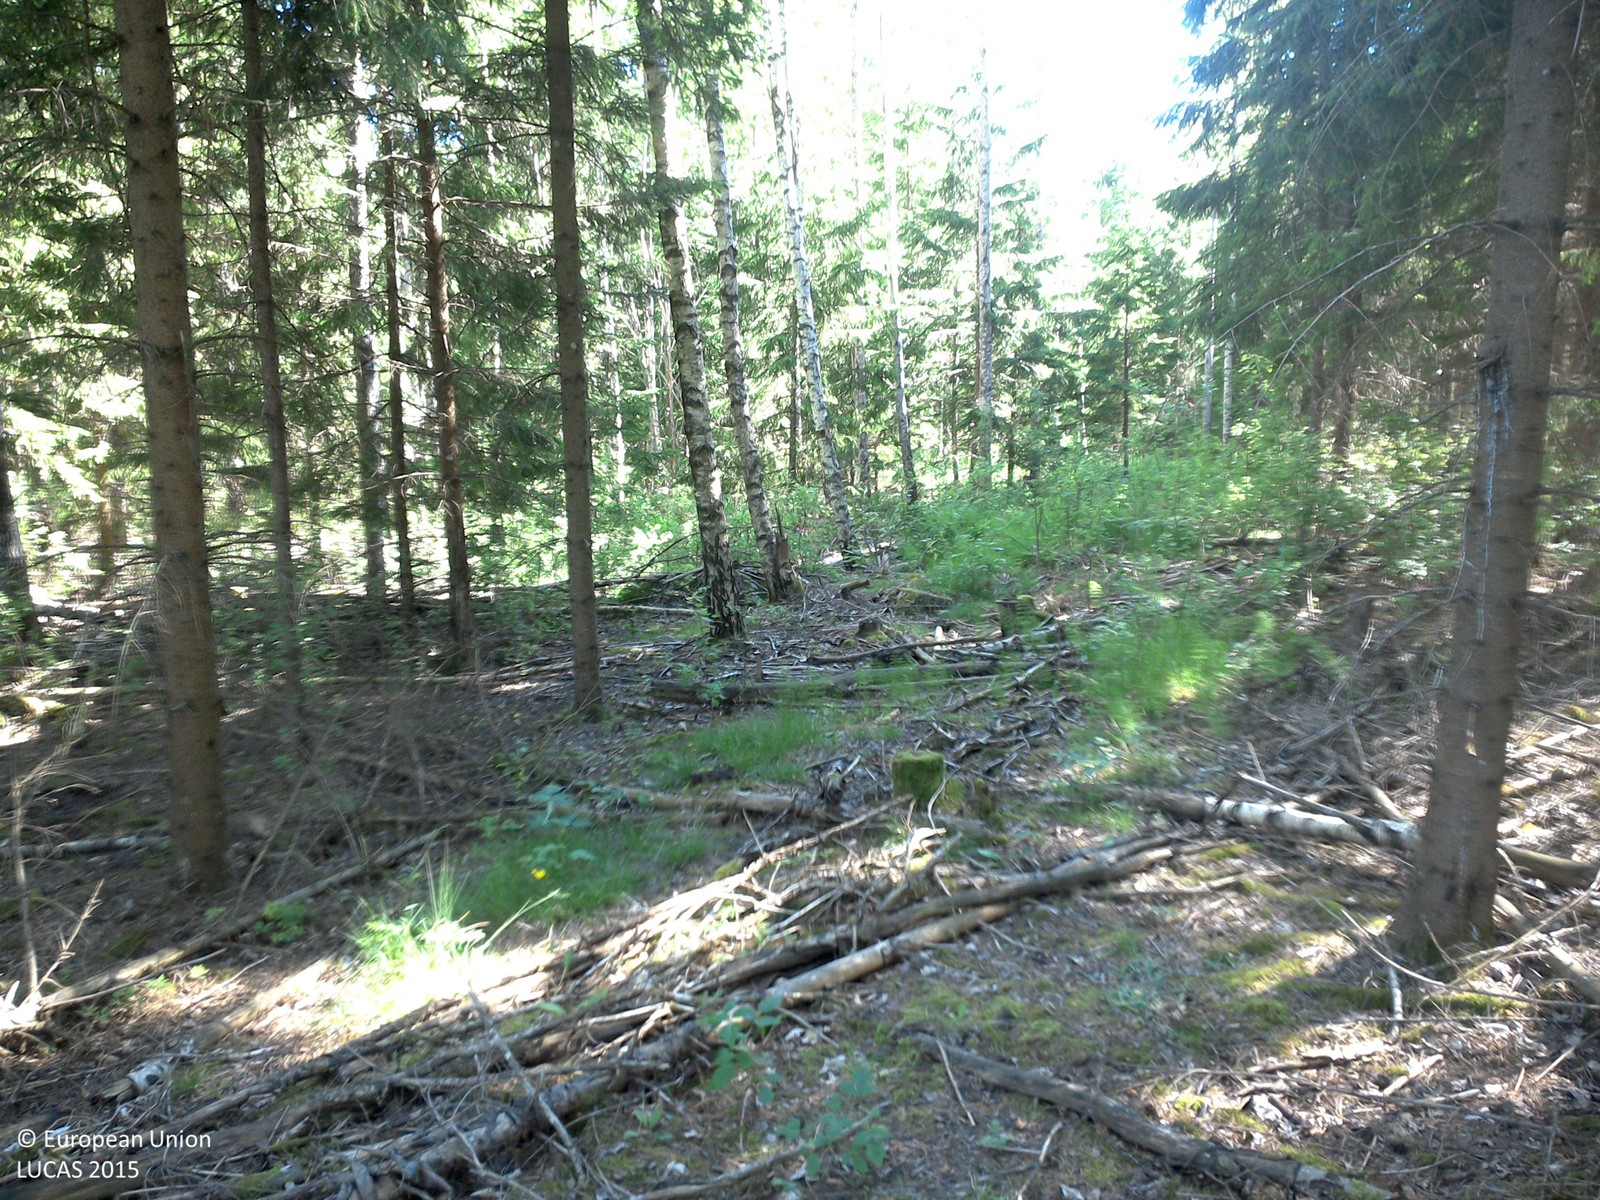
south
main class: Woodland
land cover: Spruce dominated coniferous woodland
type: boreal forest
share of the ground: > 75 %
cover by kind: coniferous forest trees 75 %, lichens and mosses 20 %, herbaceous plants 5 %
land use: Forestry
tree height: > 5 m
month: July
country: SE
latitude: 58.3451
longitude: 15.4101
